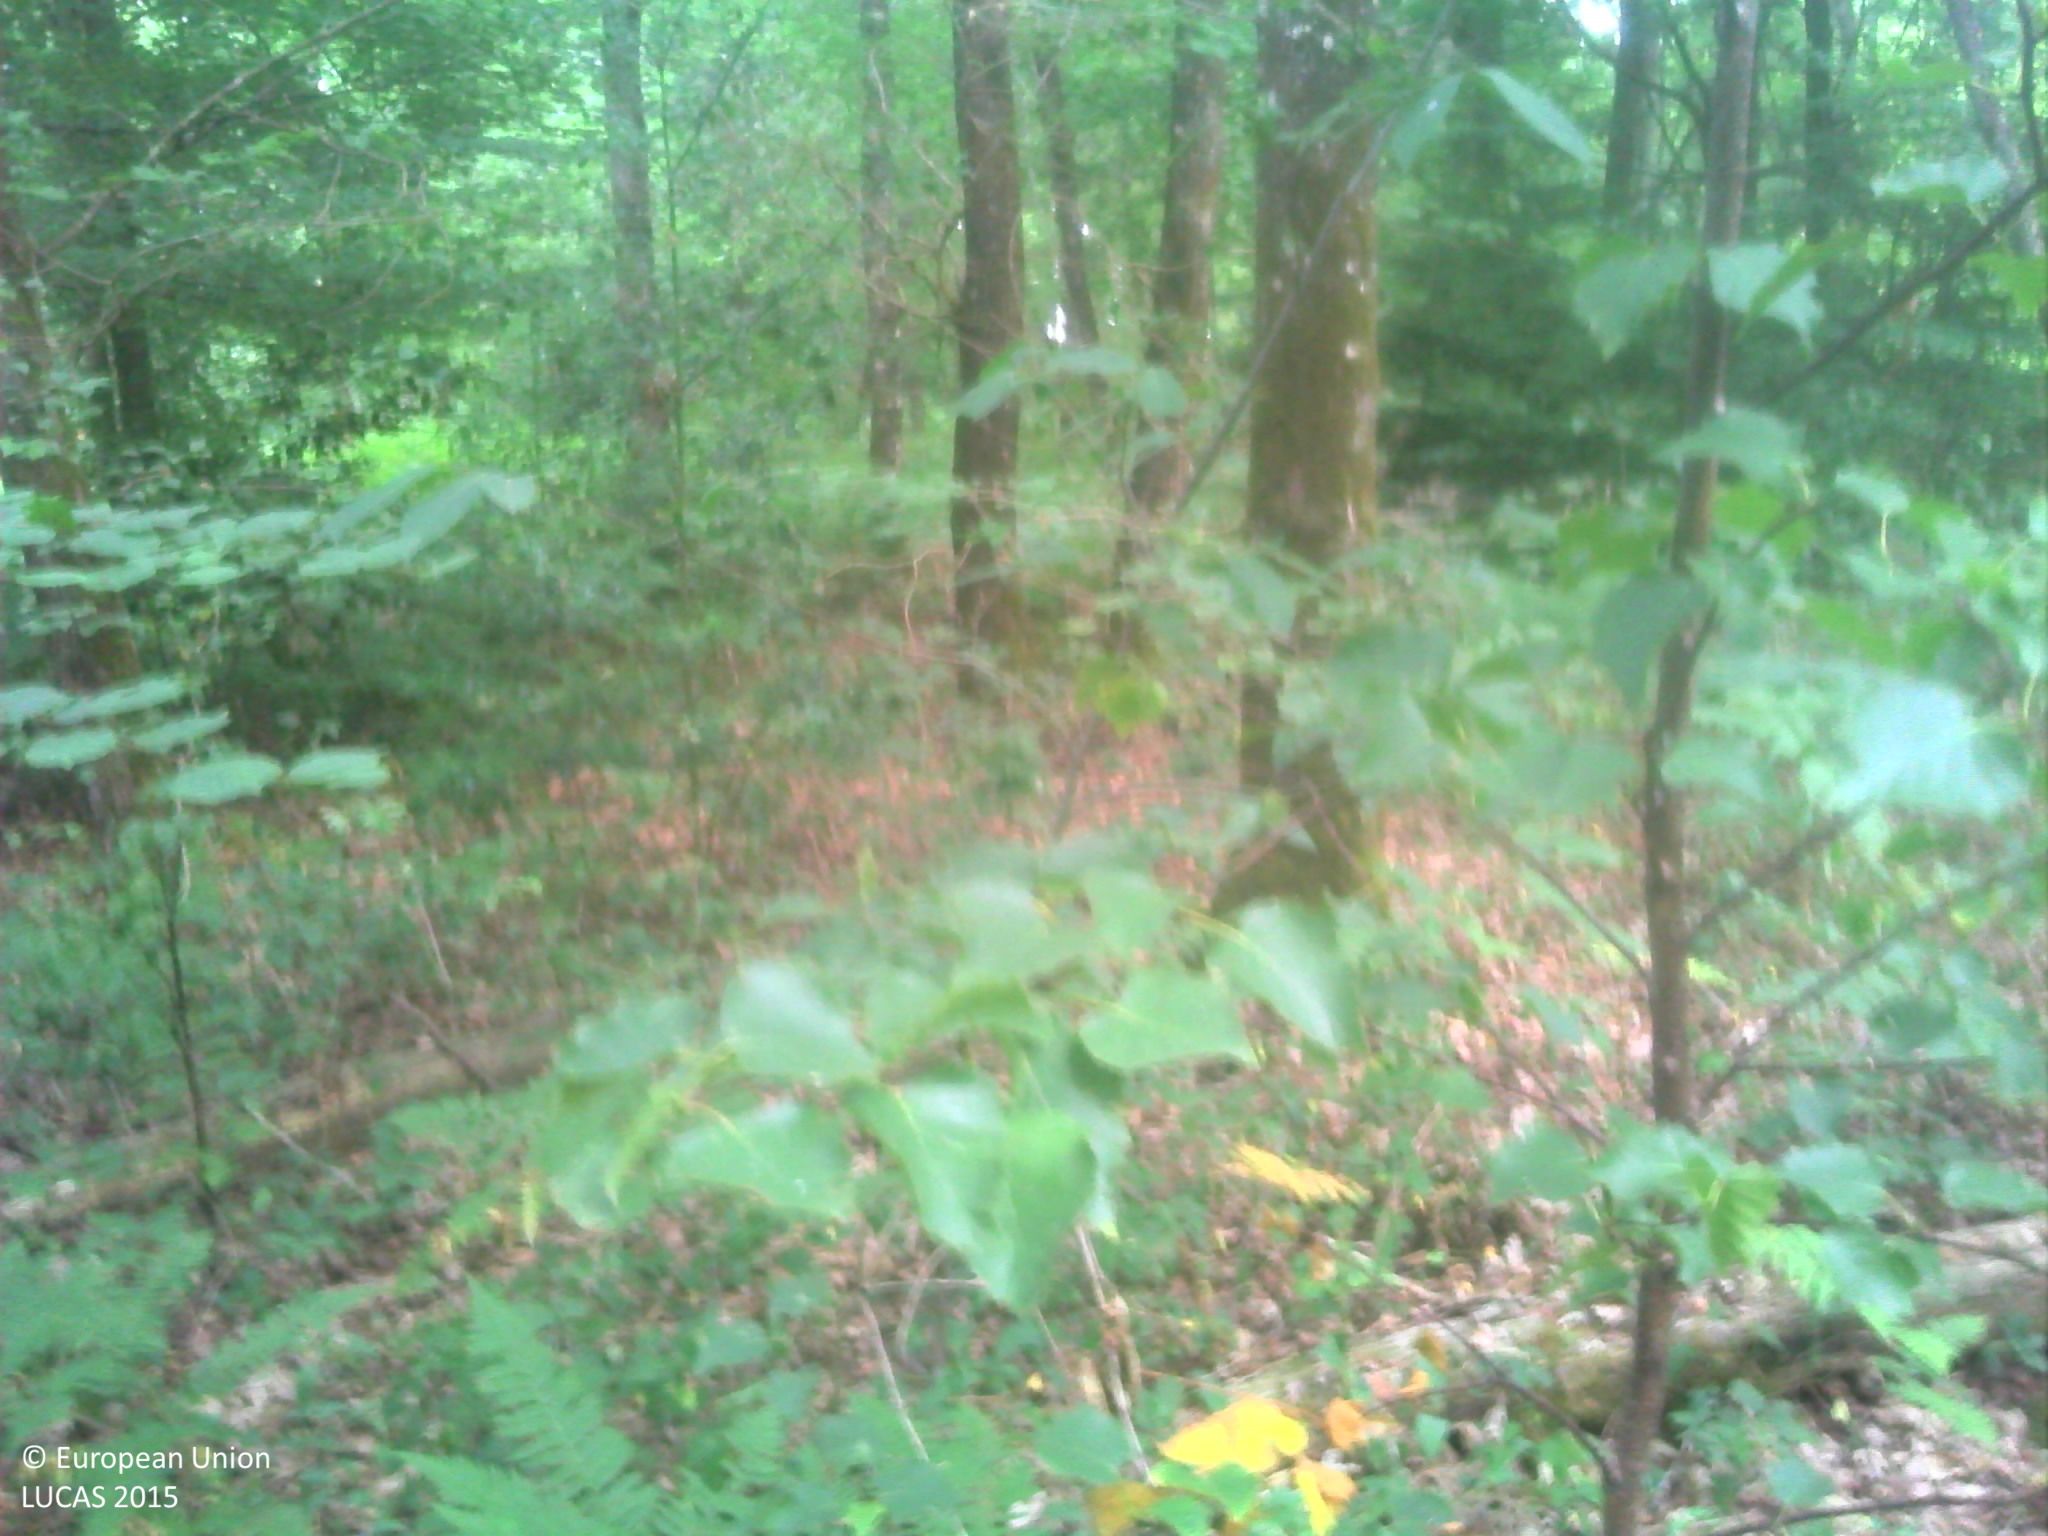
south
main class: Woodland
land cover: Broadleaved woodland
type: mesophytic deciduous forest
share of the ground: > 75 %
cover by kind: unconsolidated bare surface 50 %, herbaceous plants 30 %, broadleaved forest trees 20 %
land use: Forestry
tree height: > 5 m
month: July
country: FR
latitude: 47.8624
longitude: 1.0928
